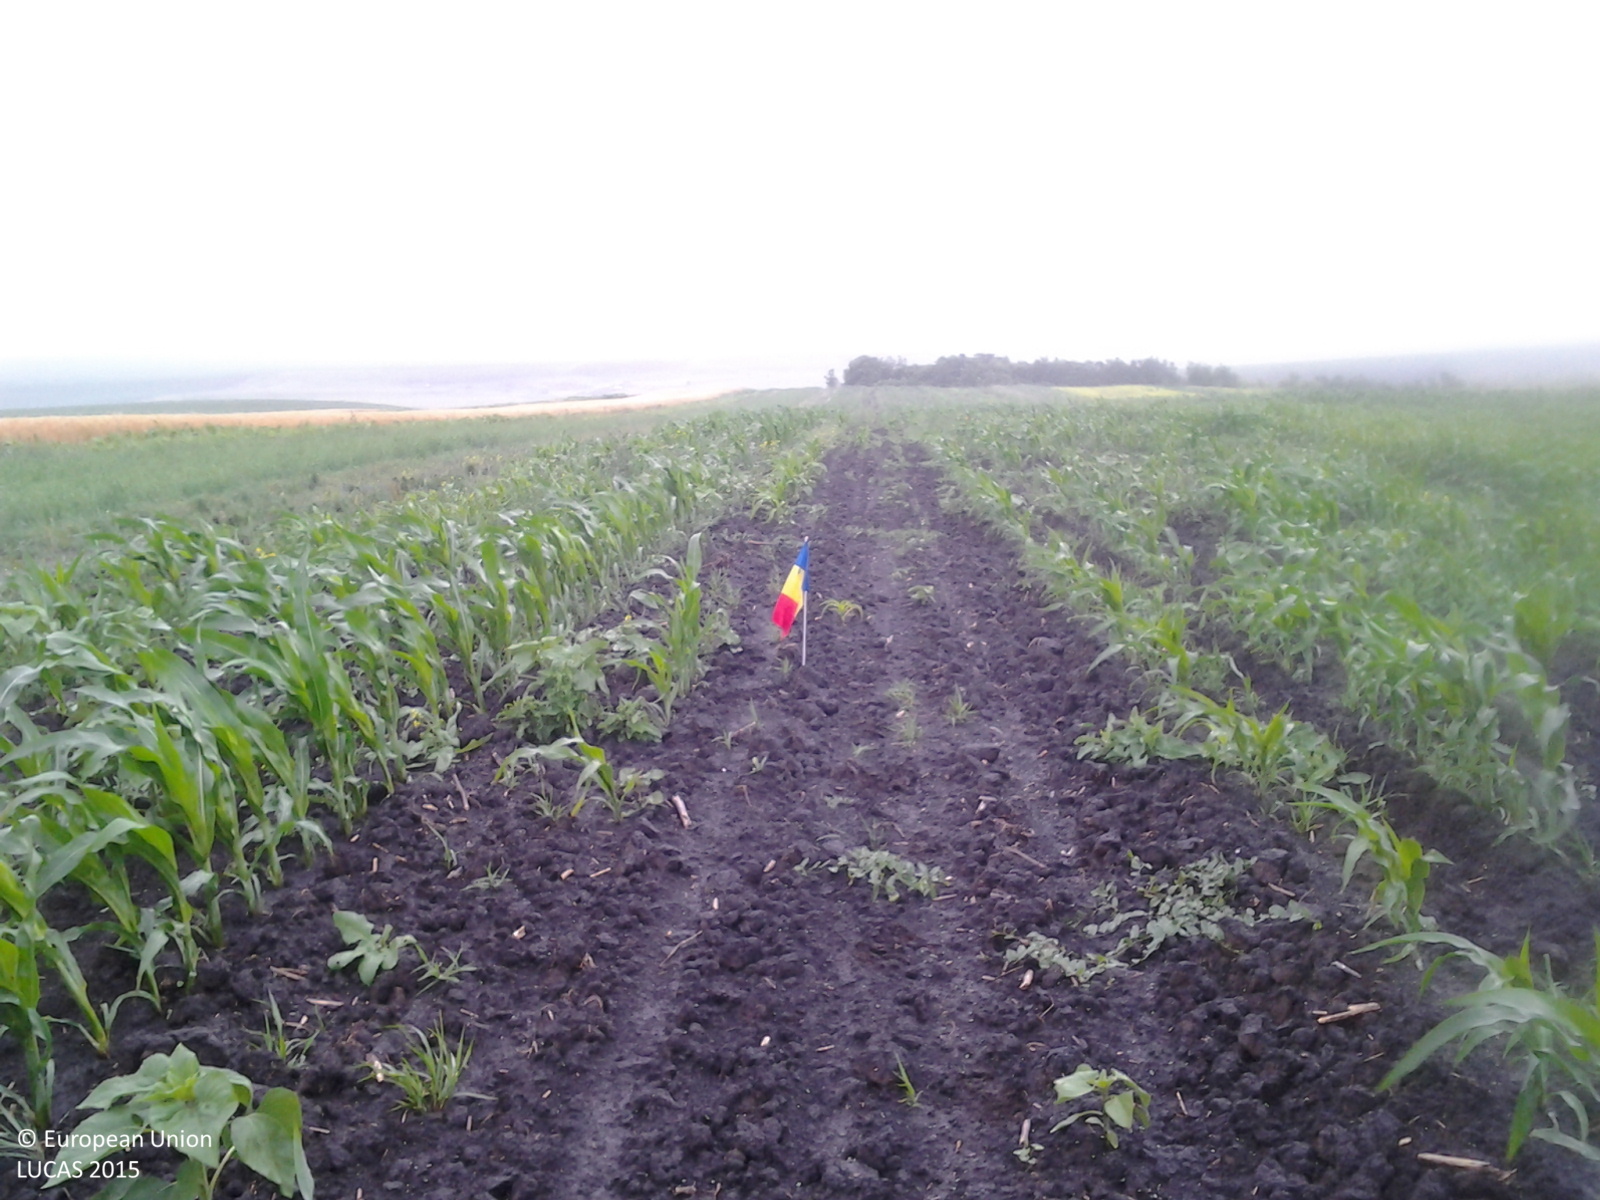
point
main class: Cropland
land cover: Maize
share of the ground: 10 - 25 %
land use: Agriculture (excluding fallow land and kitchen gardens)
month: June
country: RO
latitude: 47.9004
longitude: 26.5326
